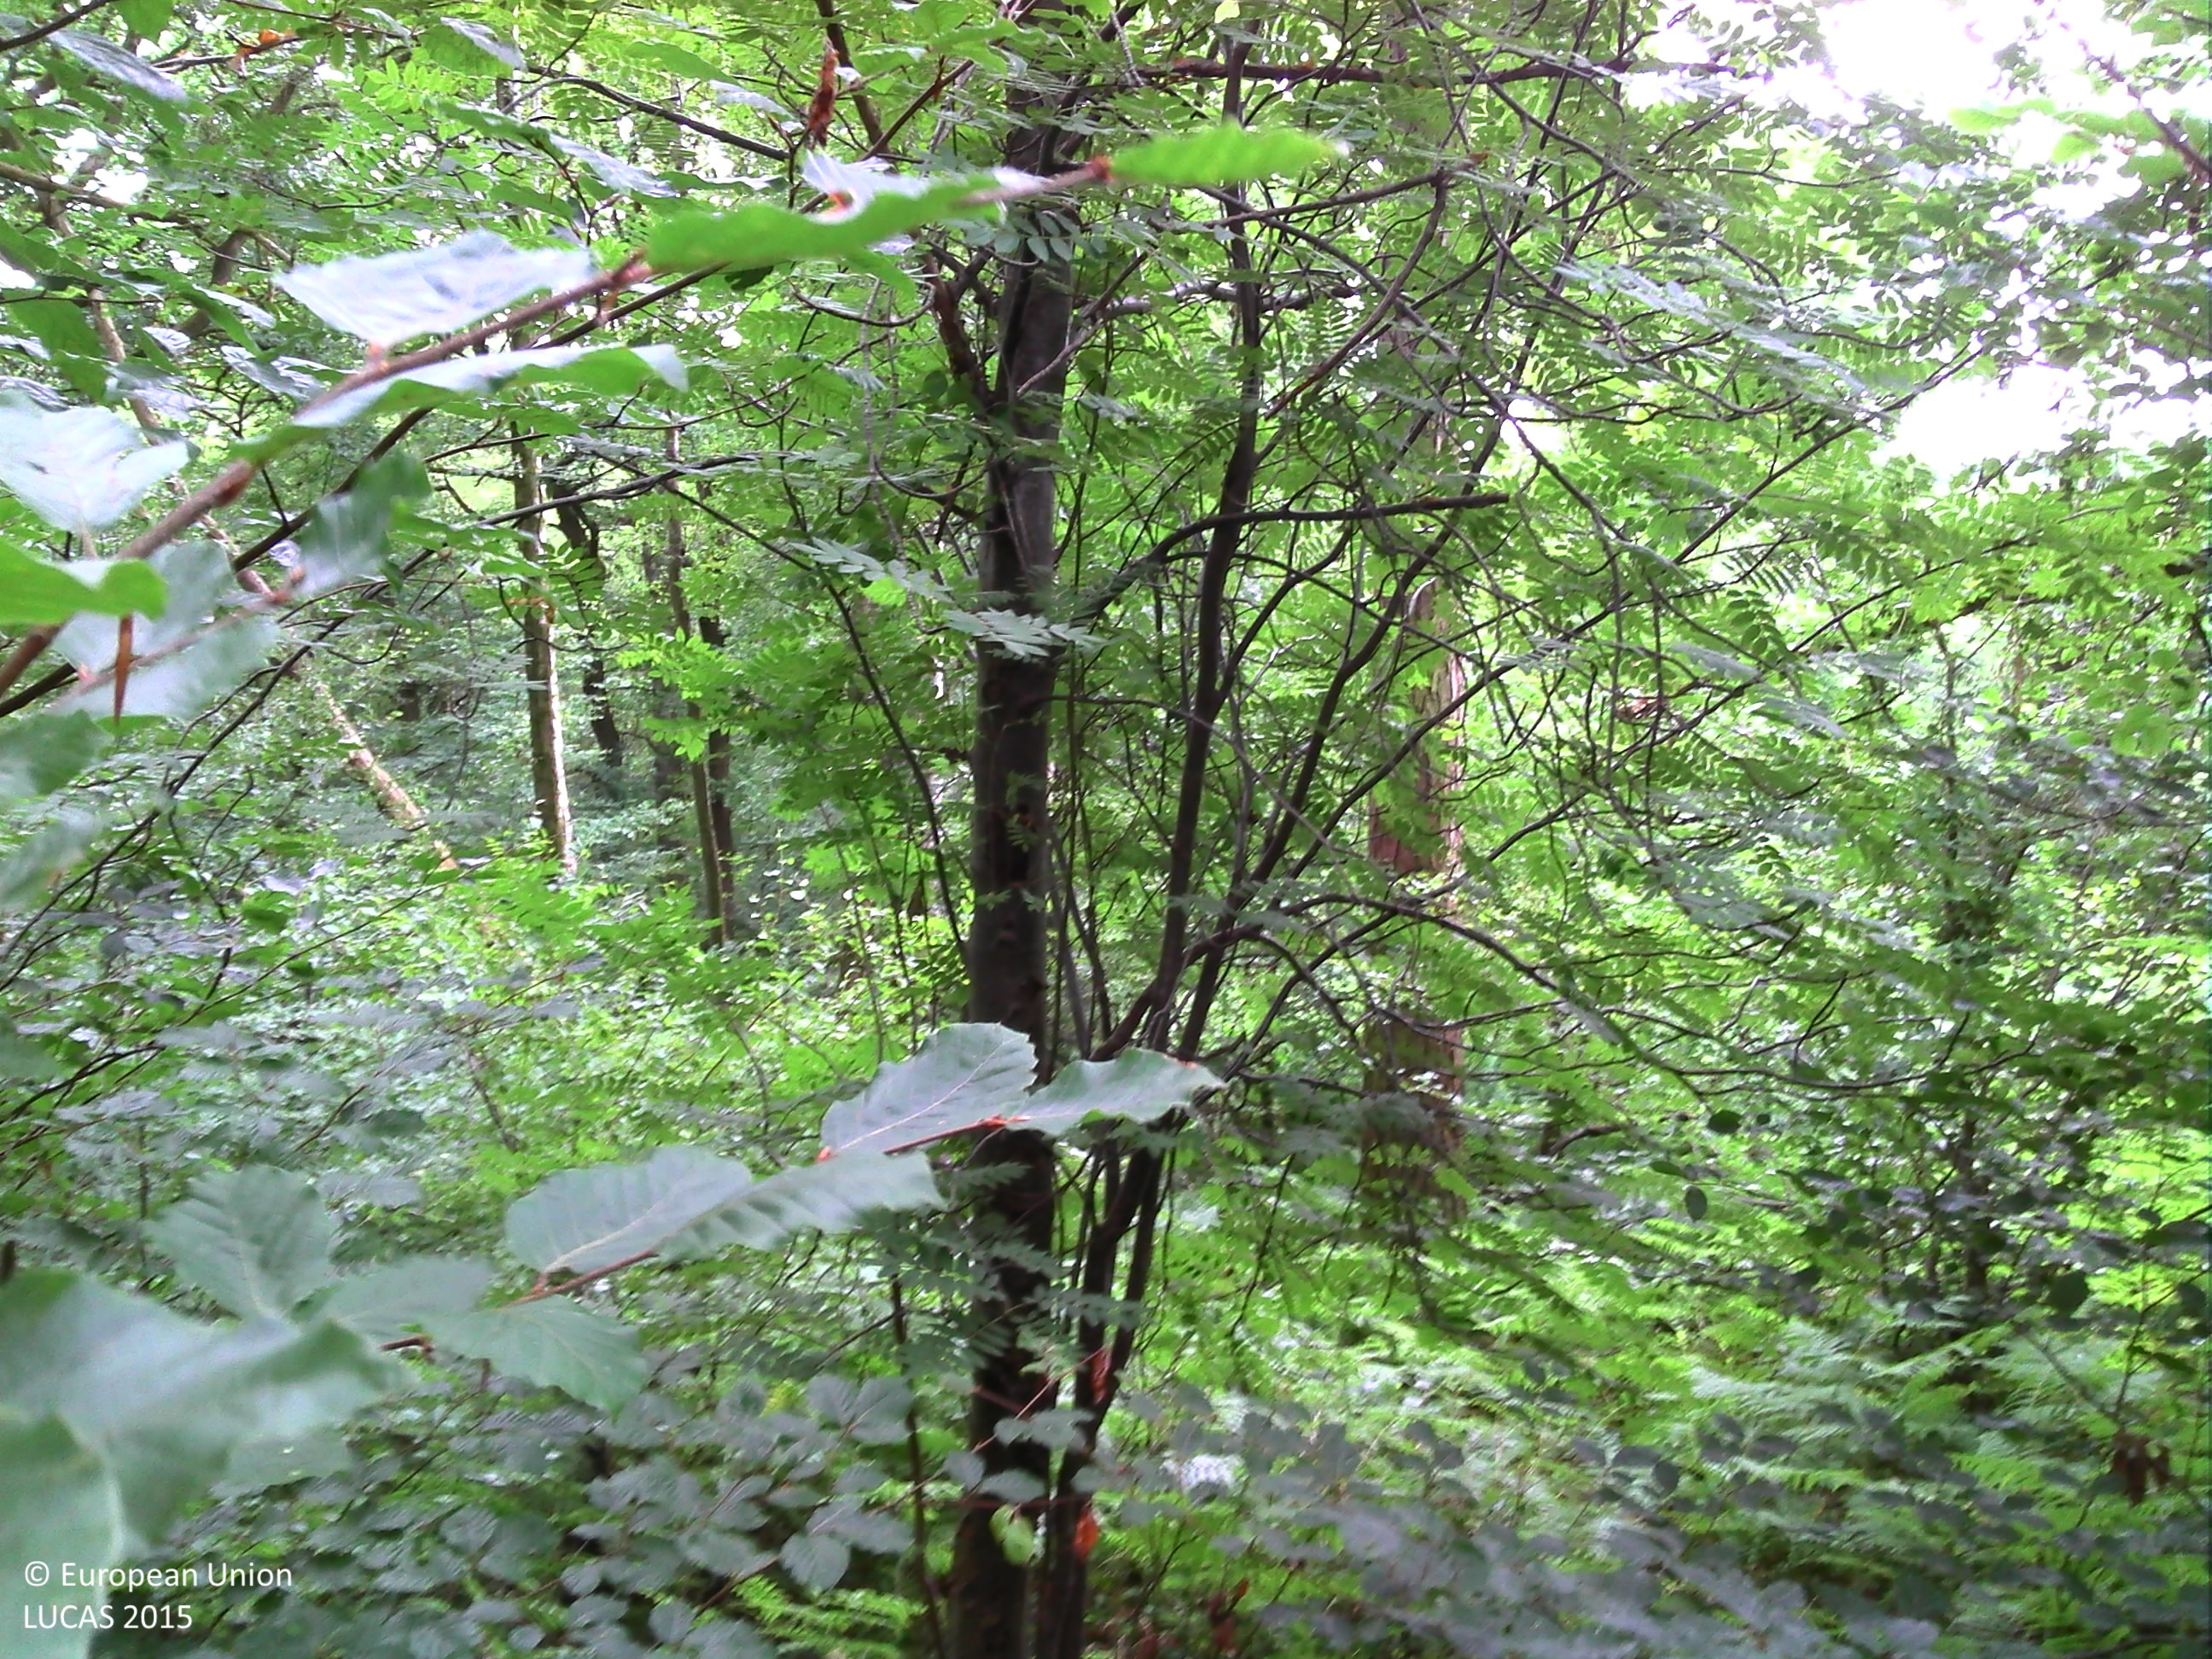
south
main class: Woodland
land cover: Broadleaved woodland
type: acidophilous oak and oak-birch forest
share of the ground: > 75 %
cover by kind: broadleaved forest trees 80 %, herbaceous plants 20 %
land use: Forestry
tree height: > 5 m
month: July
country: BE
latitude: 50.5265
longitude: 5.4700
